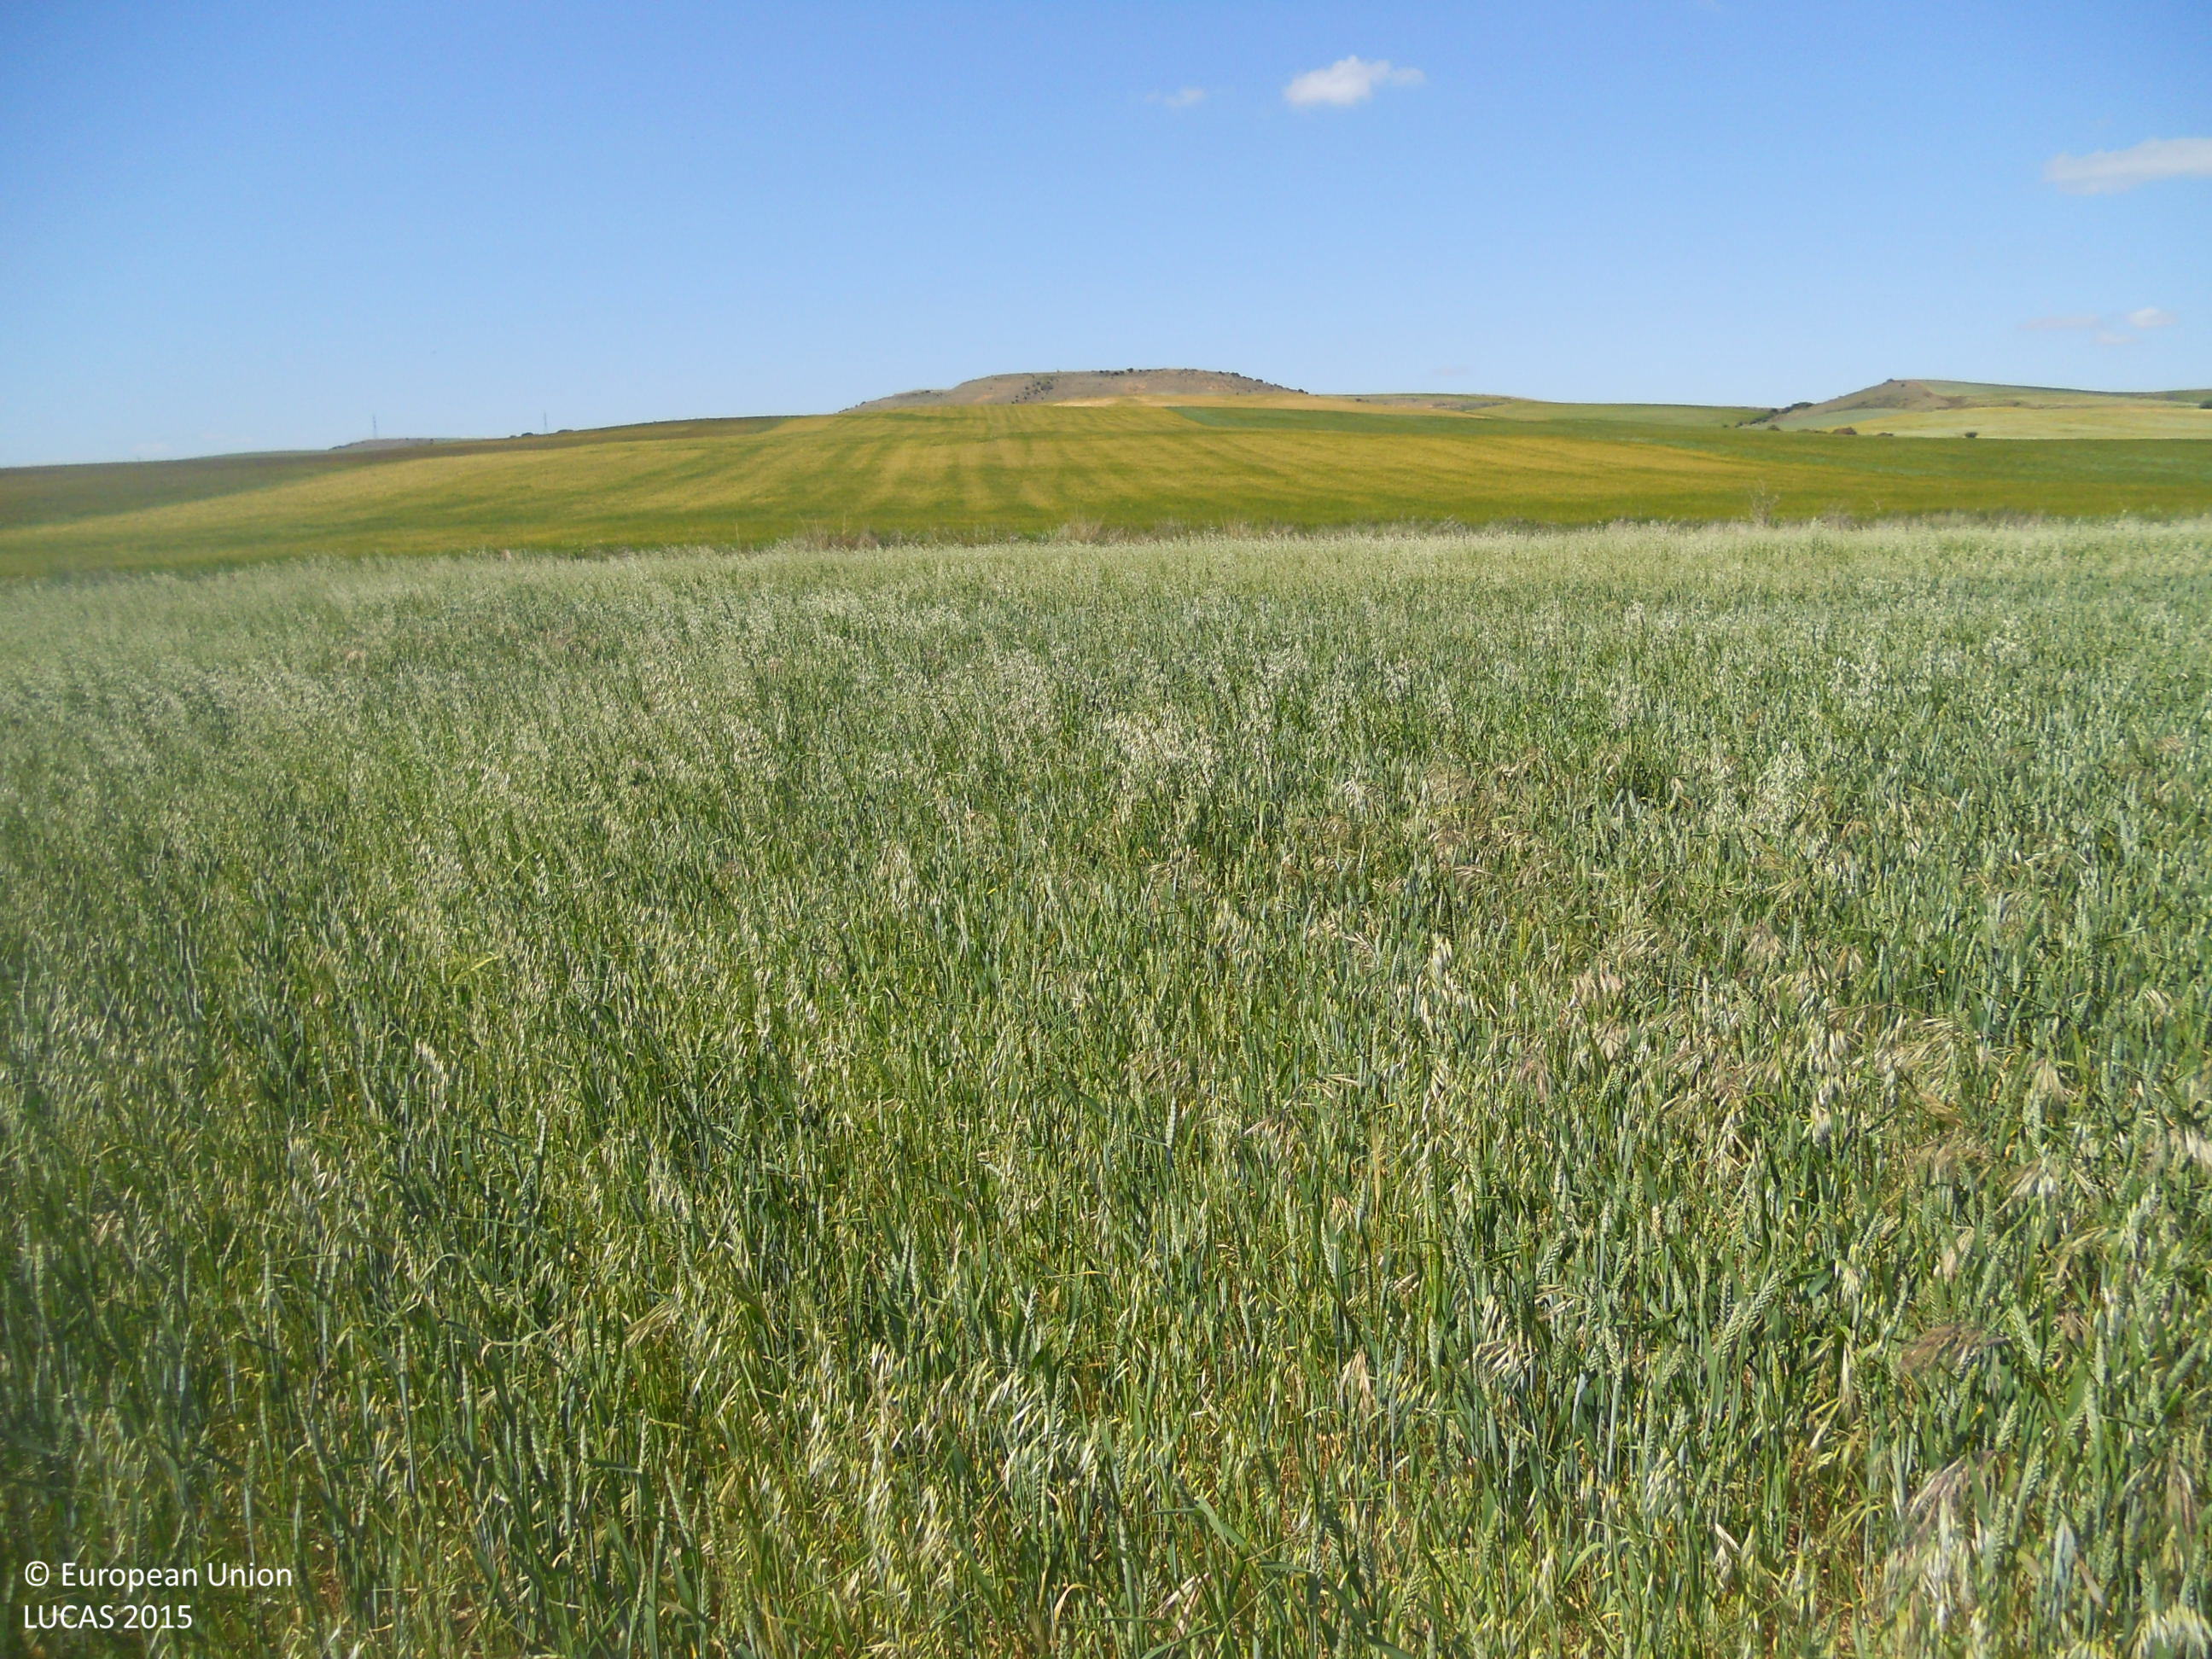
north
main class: Cropland
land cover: Common wheat
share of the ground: > 75 %
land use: Agriculture (excluding fallow land and kitchen gardens)
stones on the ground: < 10 %
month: May
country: ES
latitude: 42.3639
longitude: -4.3134
